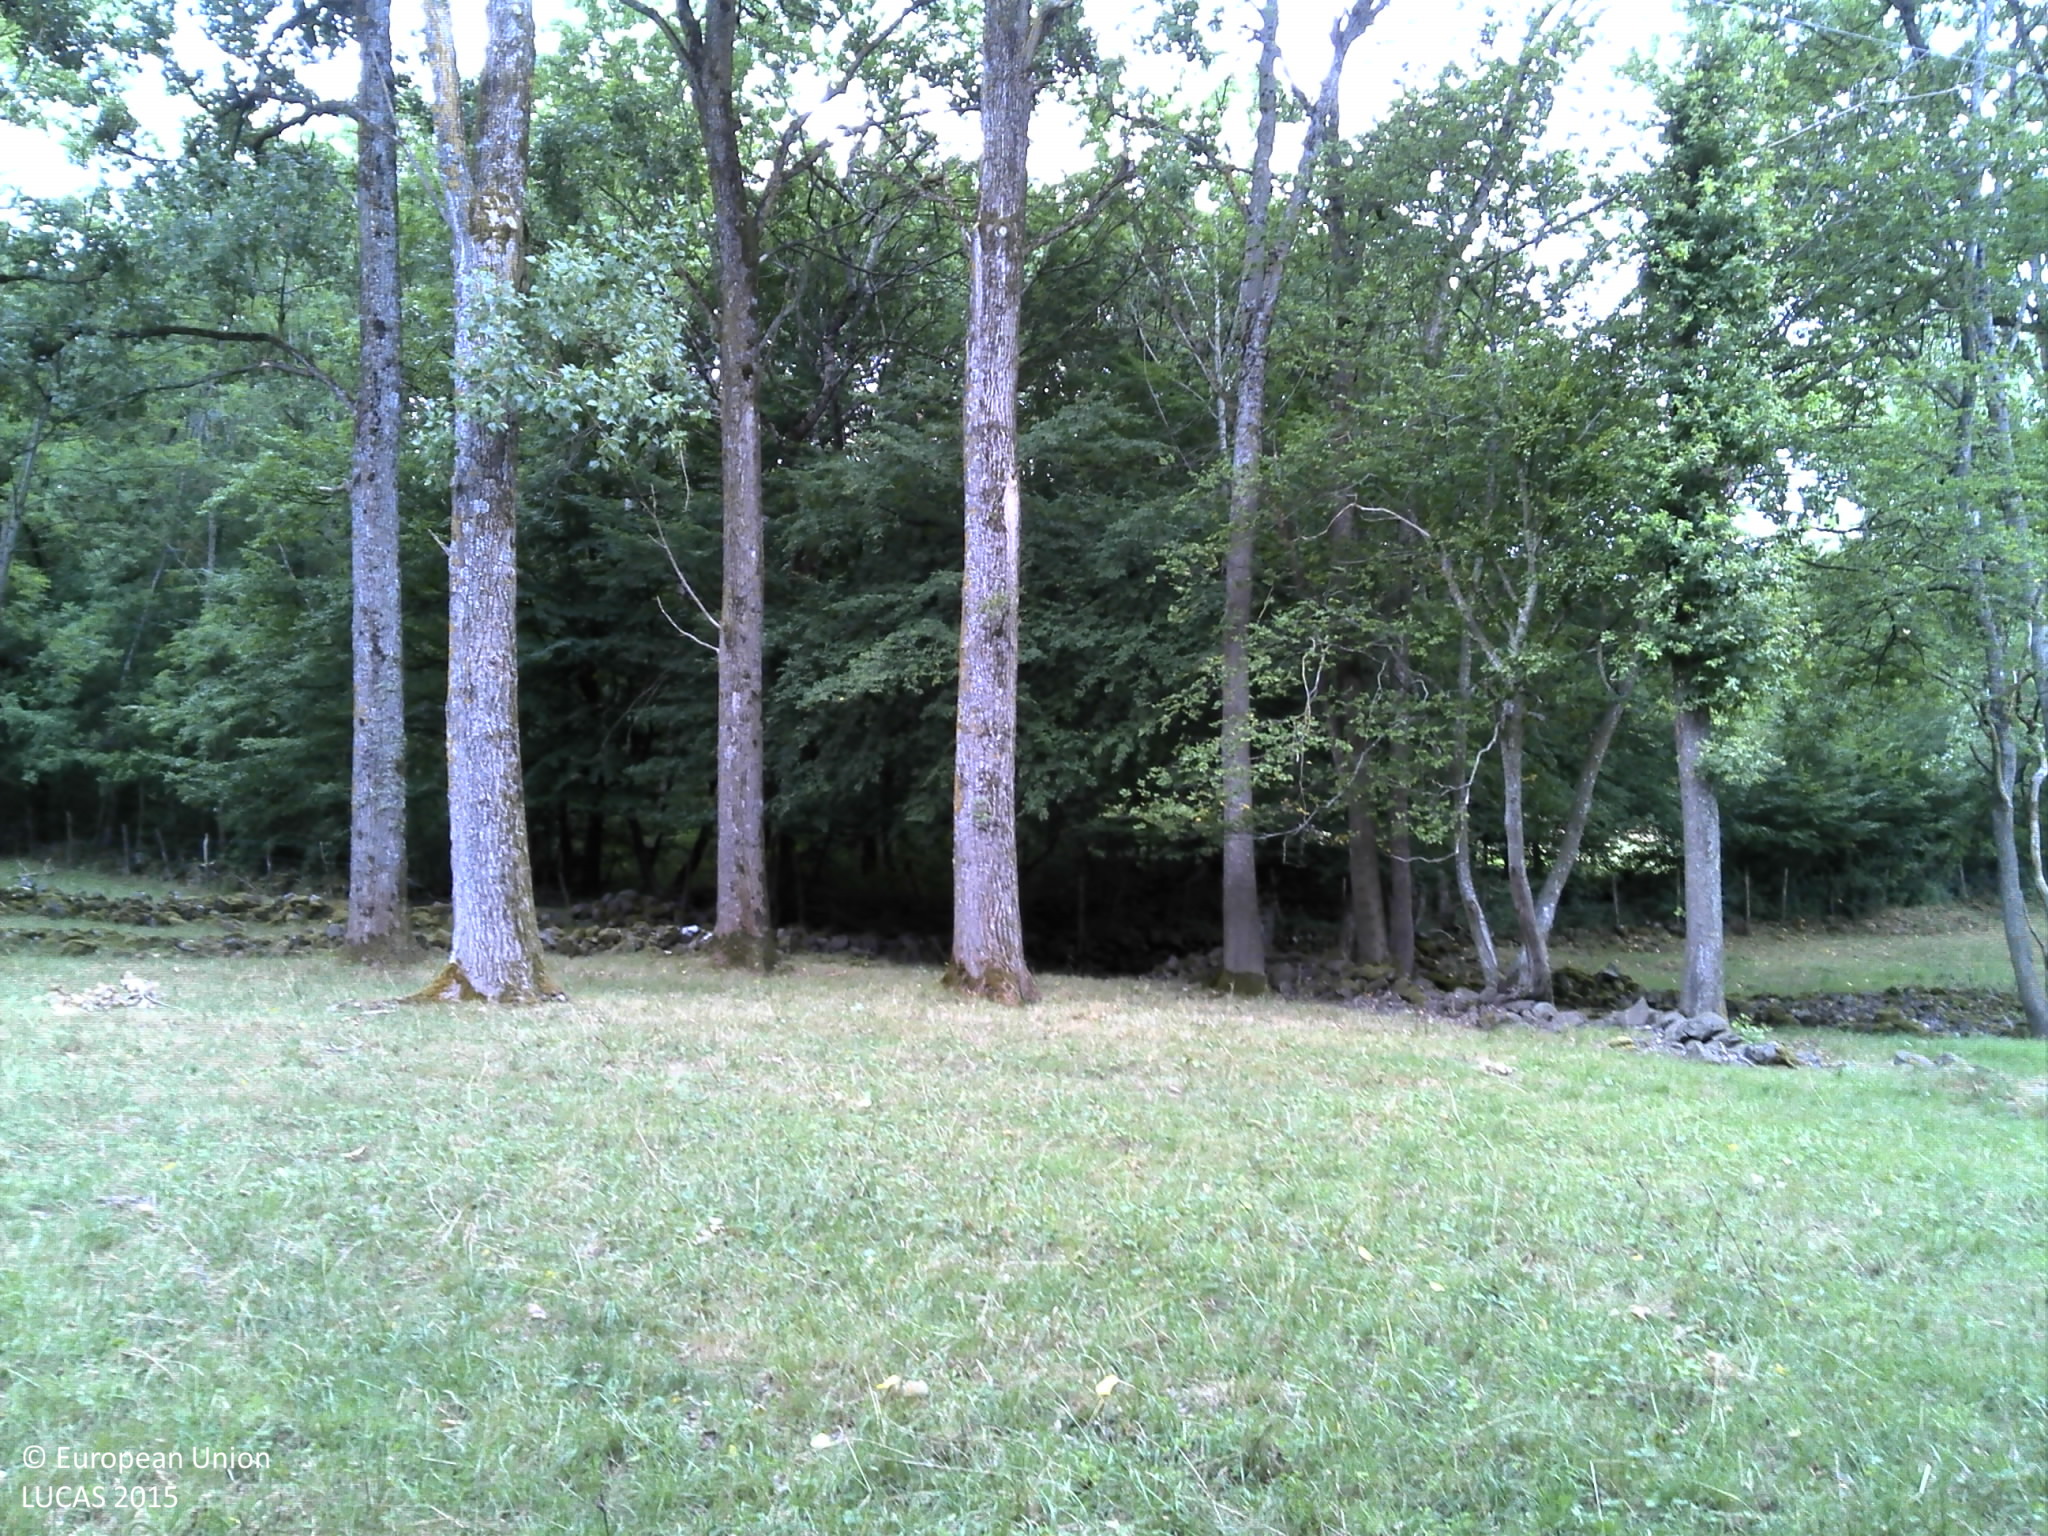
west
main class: Woodland
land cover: Broadleaved woodland
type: mesophytic deciduous forest
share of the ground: 25 - 50 %
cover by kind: herbaceous plants 50 %, broadleaved forest trees 40 %, shrubs 10 %
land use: Forestry
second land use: Agriculture (excluding fallow land and kitchen gardens)
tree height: > 5 m
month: July
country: FR
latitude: 45.6736
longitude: 3.3383
